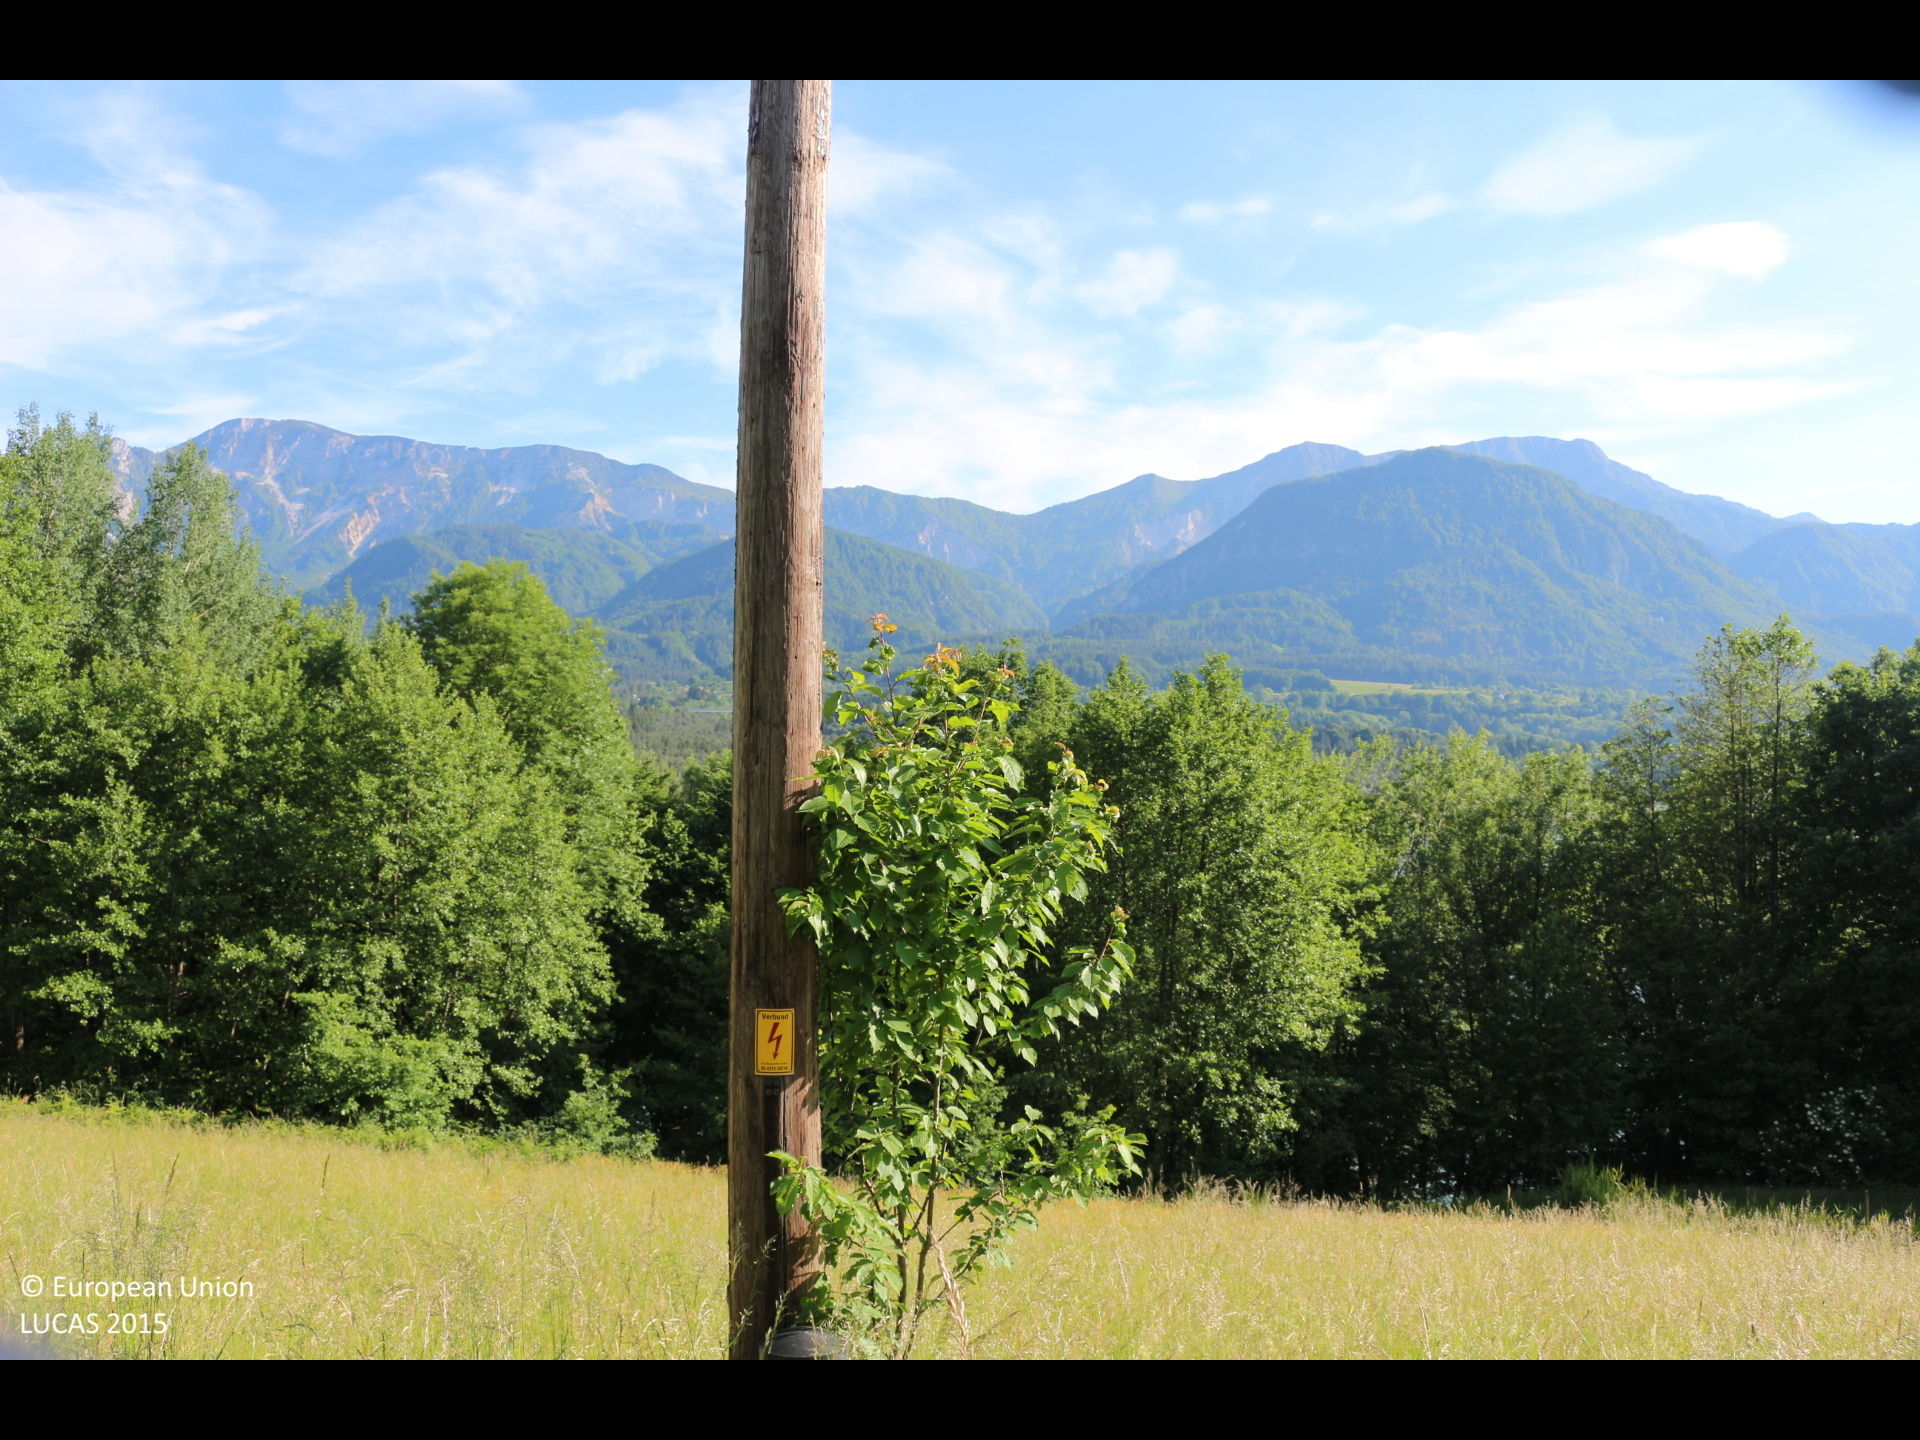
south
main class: Grassland
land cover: Grassland without tree/shrub cover
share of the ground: > 75 %
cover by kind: herbaceous plants 100 %
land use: Agriculture (excluding fallow land and kitchen gardens)
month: May
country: AT
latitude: 46.5429
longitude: 14.1050
